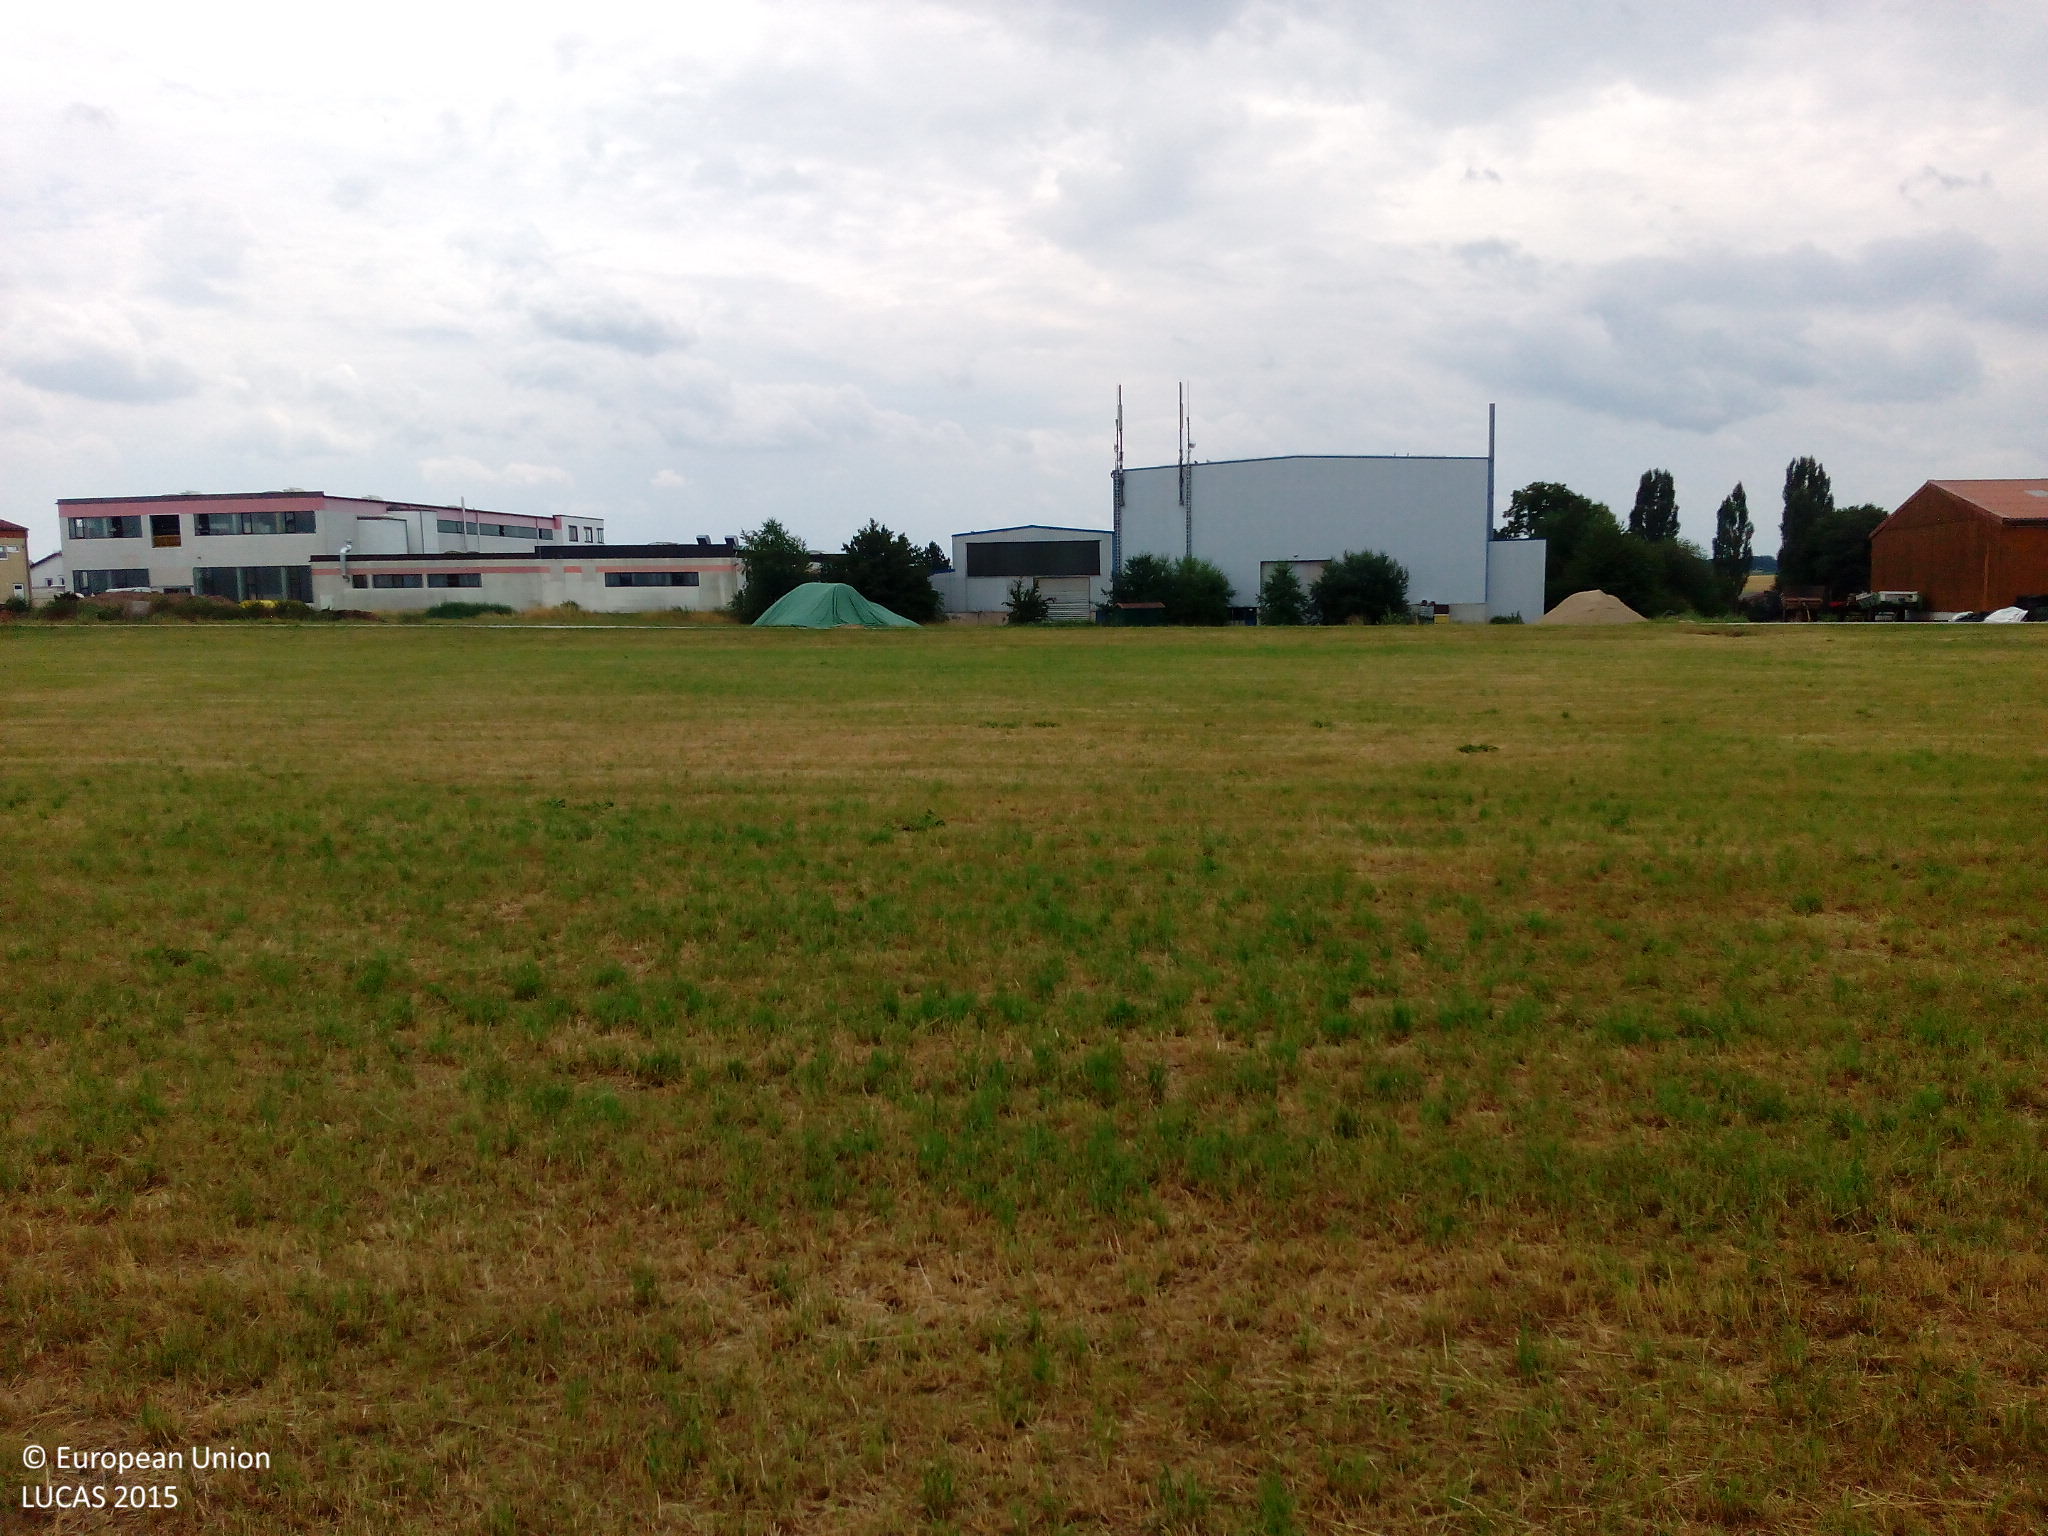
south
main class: Grassland
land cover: Grassland without tree/shrub cover
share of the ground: > 75 %
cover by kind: herbaceous plants 90 %, unconsolidated bare surface 10 %
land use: Agriculture (excluding fallow land and kitchen gardens)
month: July
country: DE
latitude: 49.5330
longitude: 10.9254
